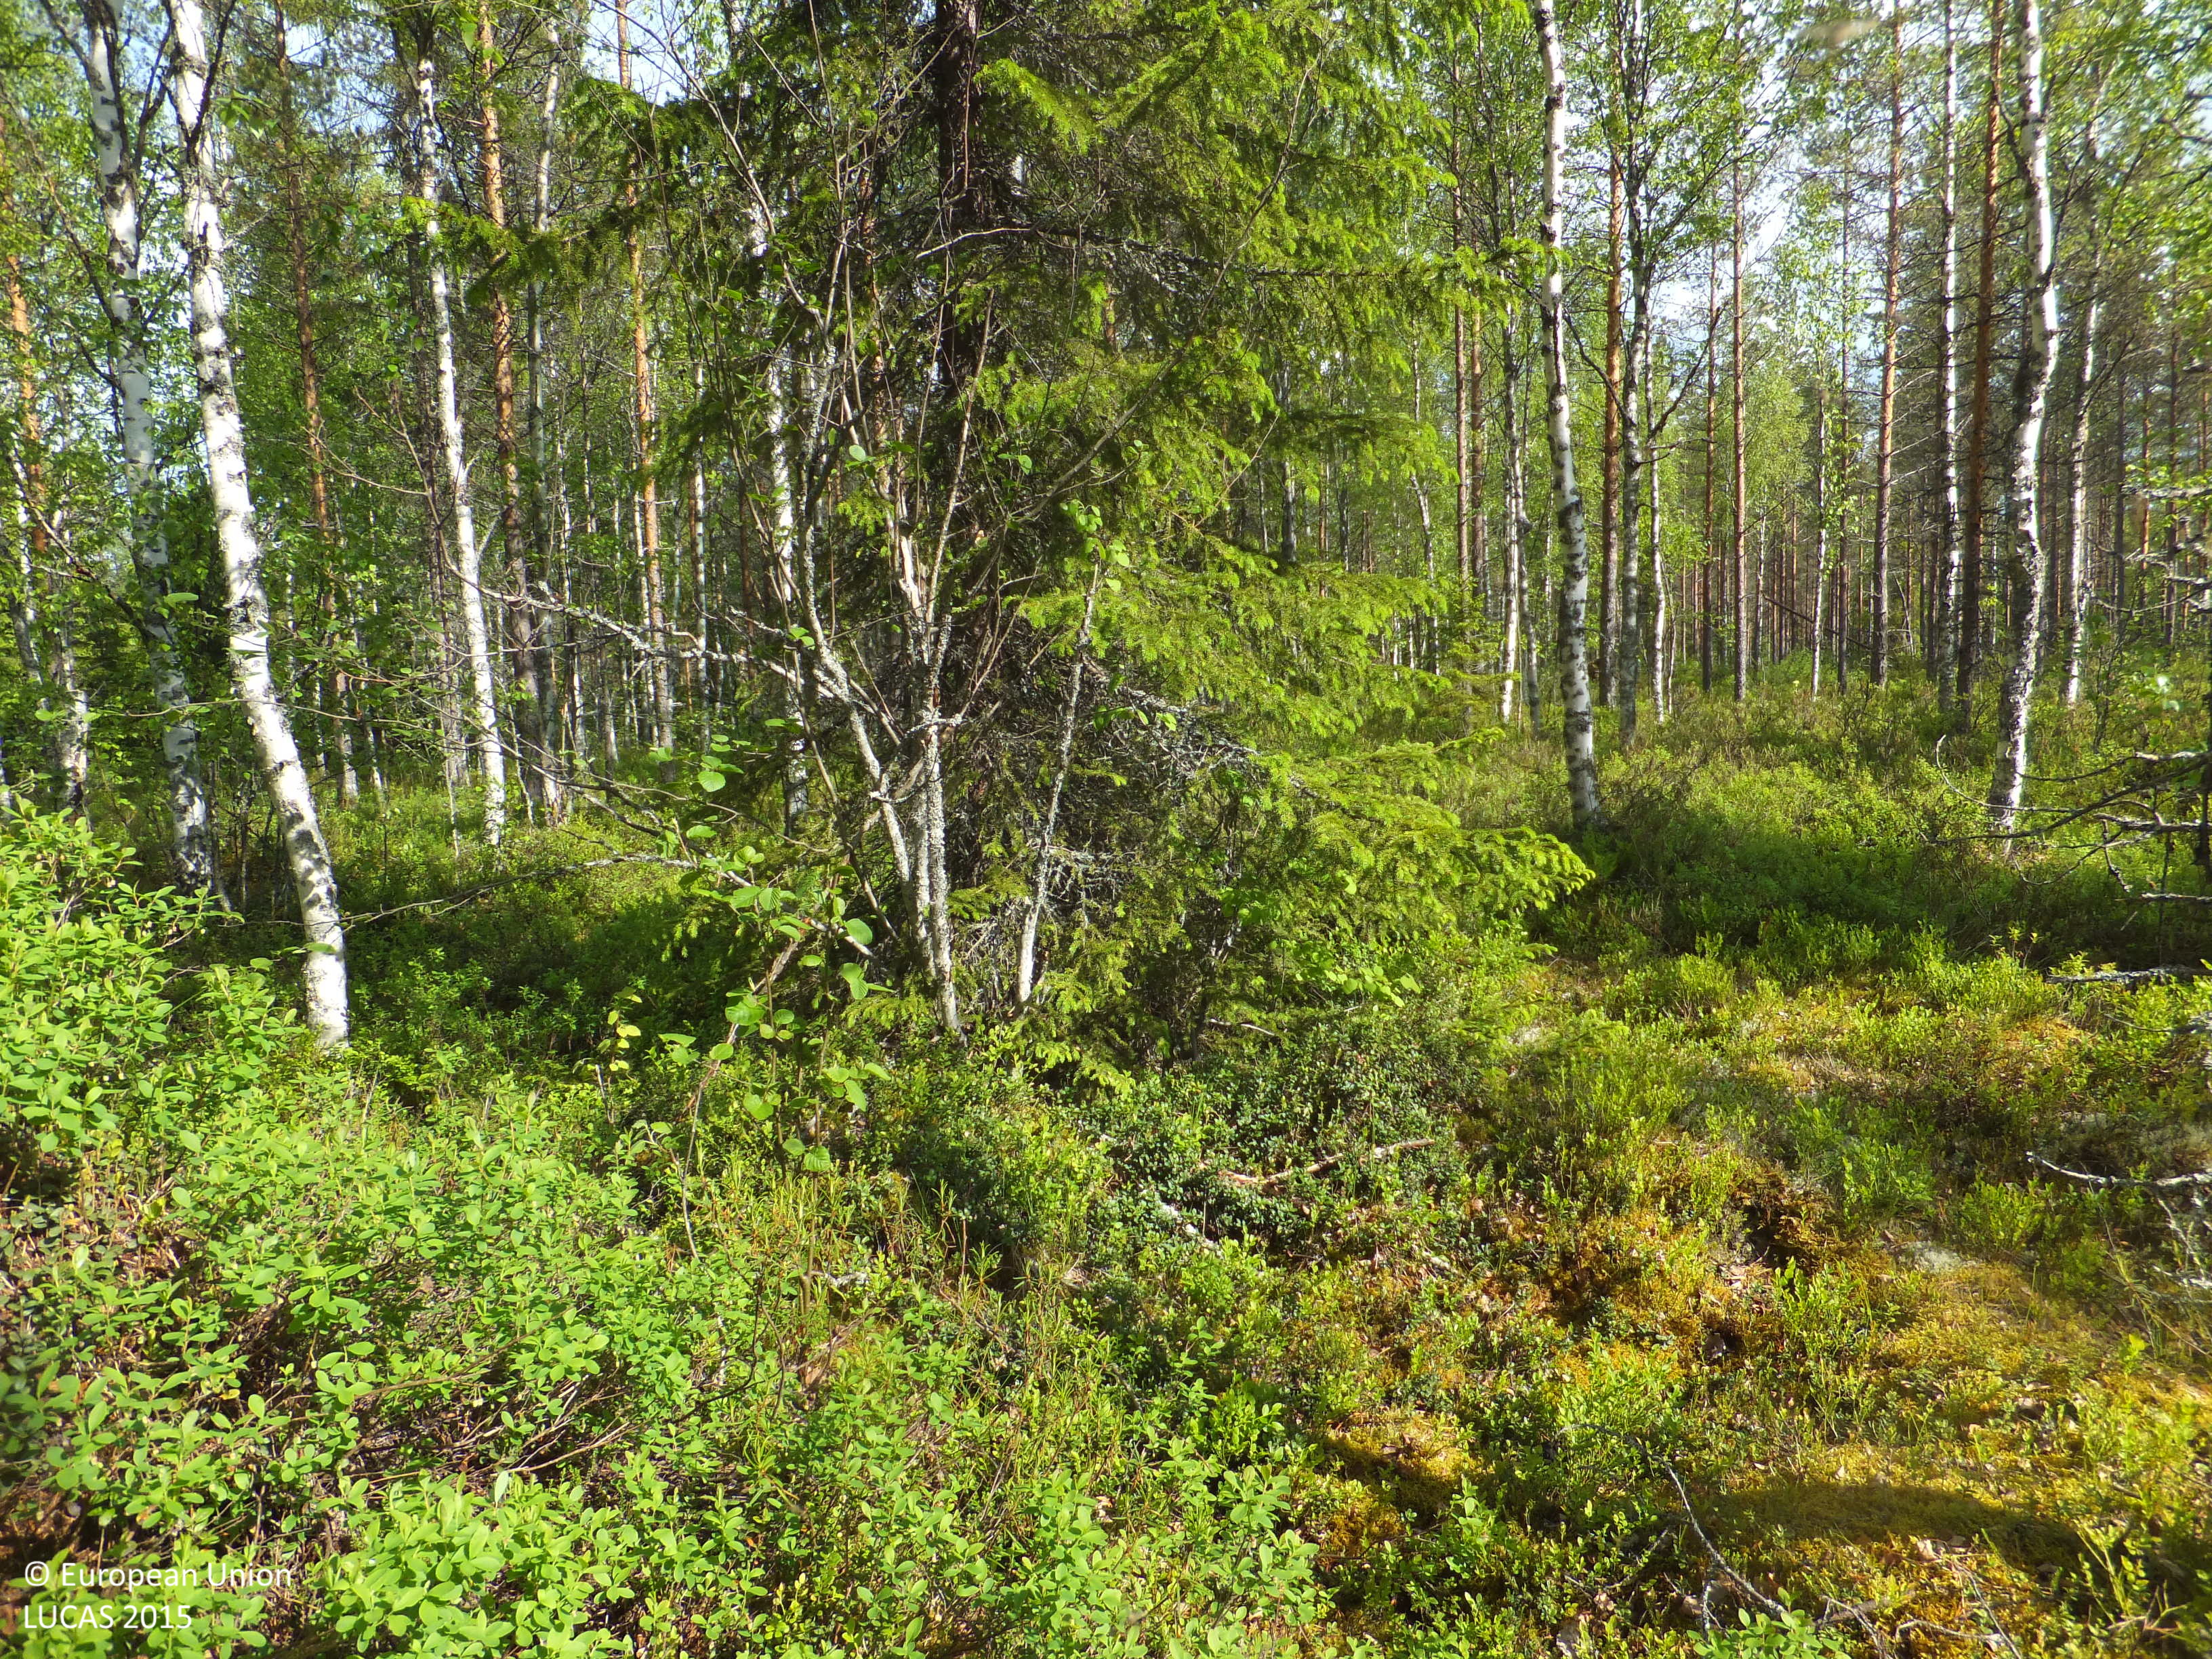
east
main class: Woodland
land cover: Broadleaved woodland
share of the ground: 50 - 75 %
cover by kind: broadleaved forest trees 50 %, shrubs 20 %, lichens and mosses 15 %, coniferous forest trees 10 %, consolidated bare surface 5 %
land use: Forestry
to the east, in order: Broadleaved woodland; Spruce dominated mixed woodland; Ditches and canals; Pine dominated mixed woodland; Ditches and canals; Pine dominated mixed woodland; Other coniferous woodland; Ditches and canals; Other mixed woodland
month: June
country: FI
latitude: 63.6983
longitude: 24.9961
